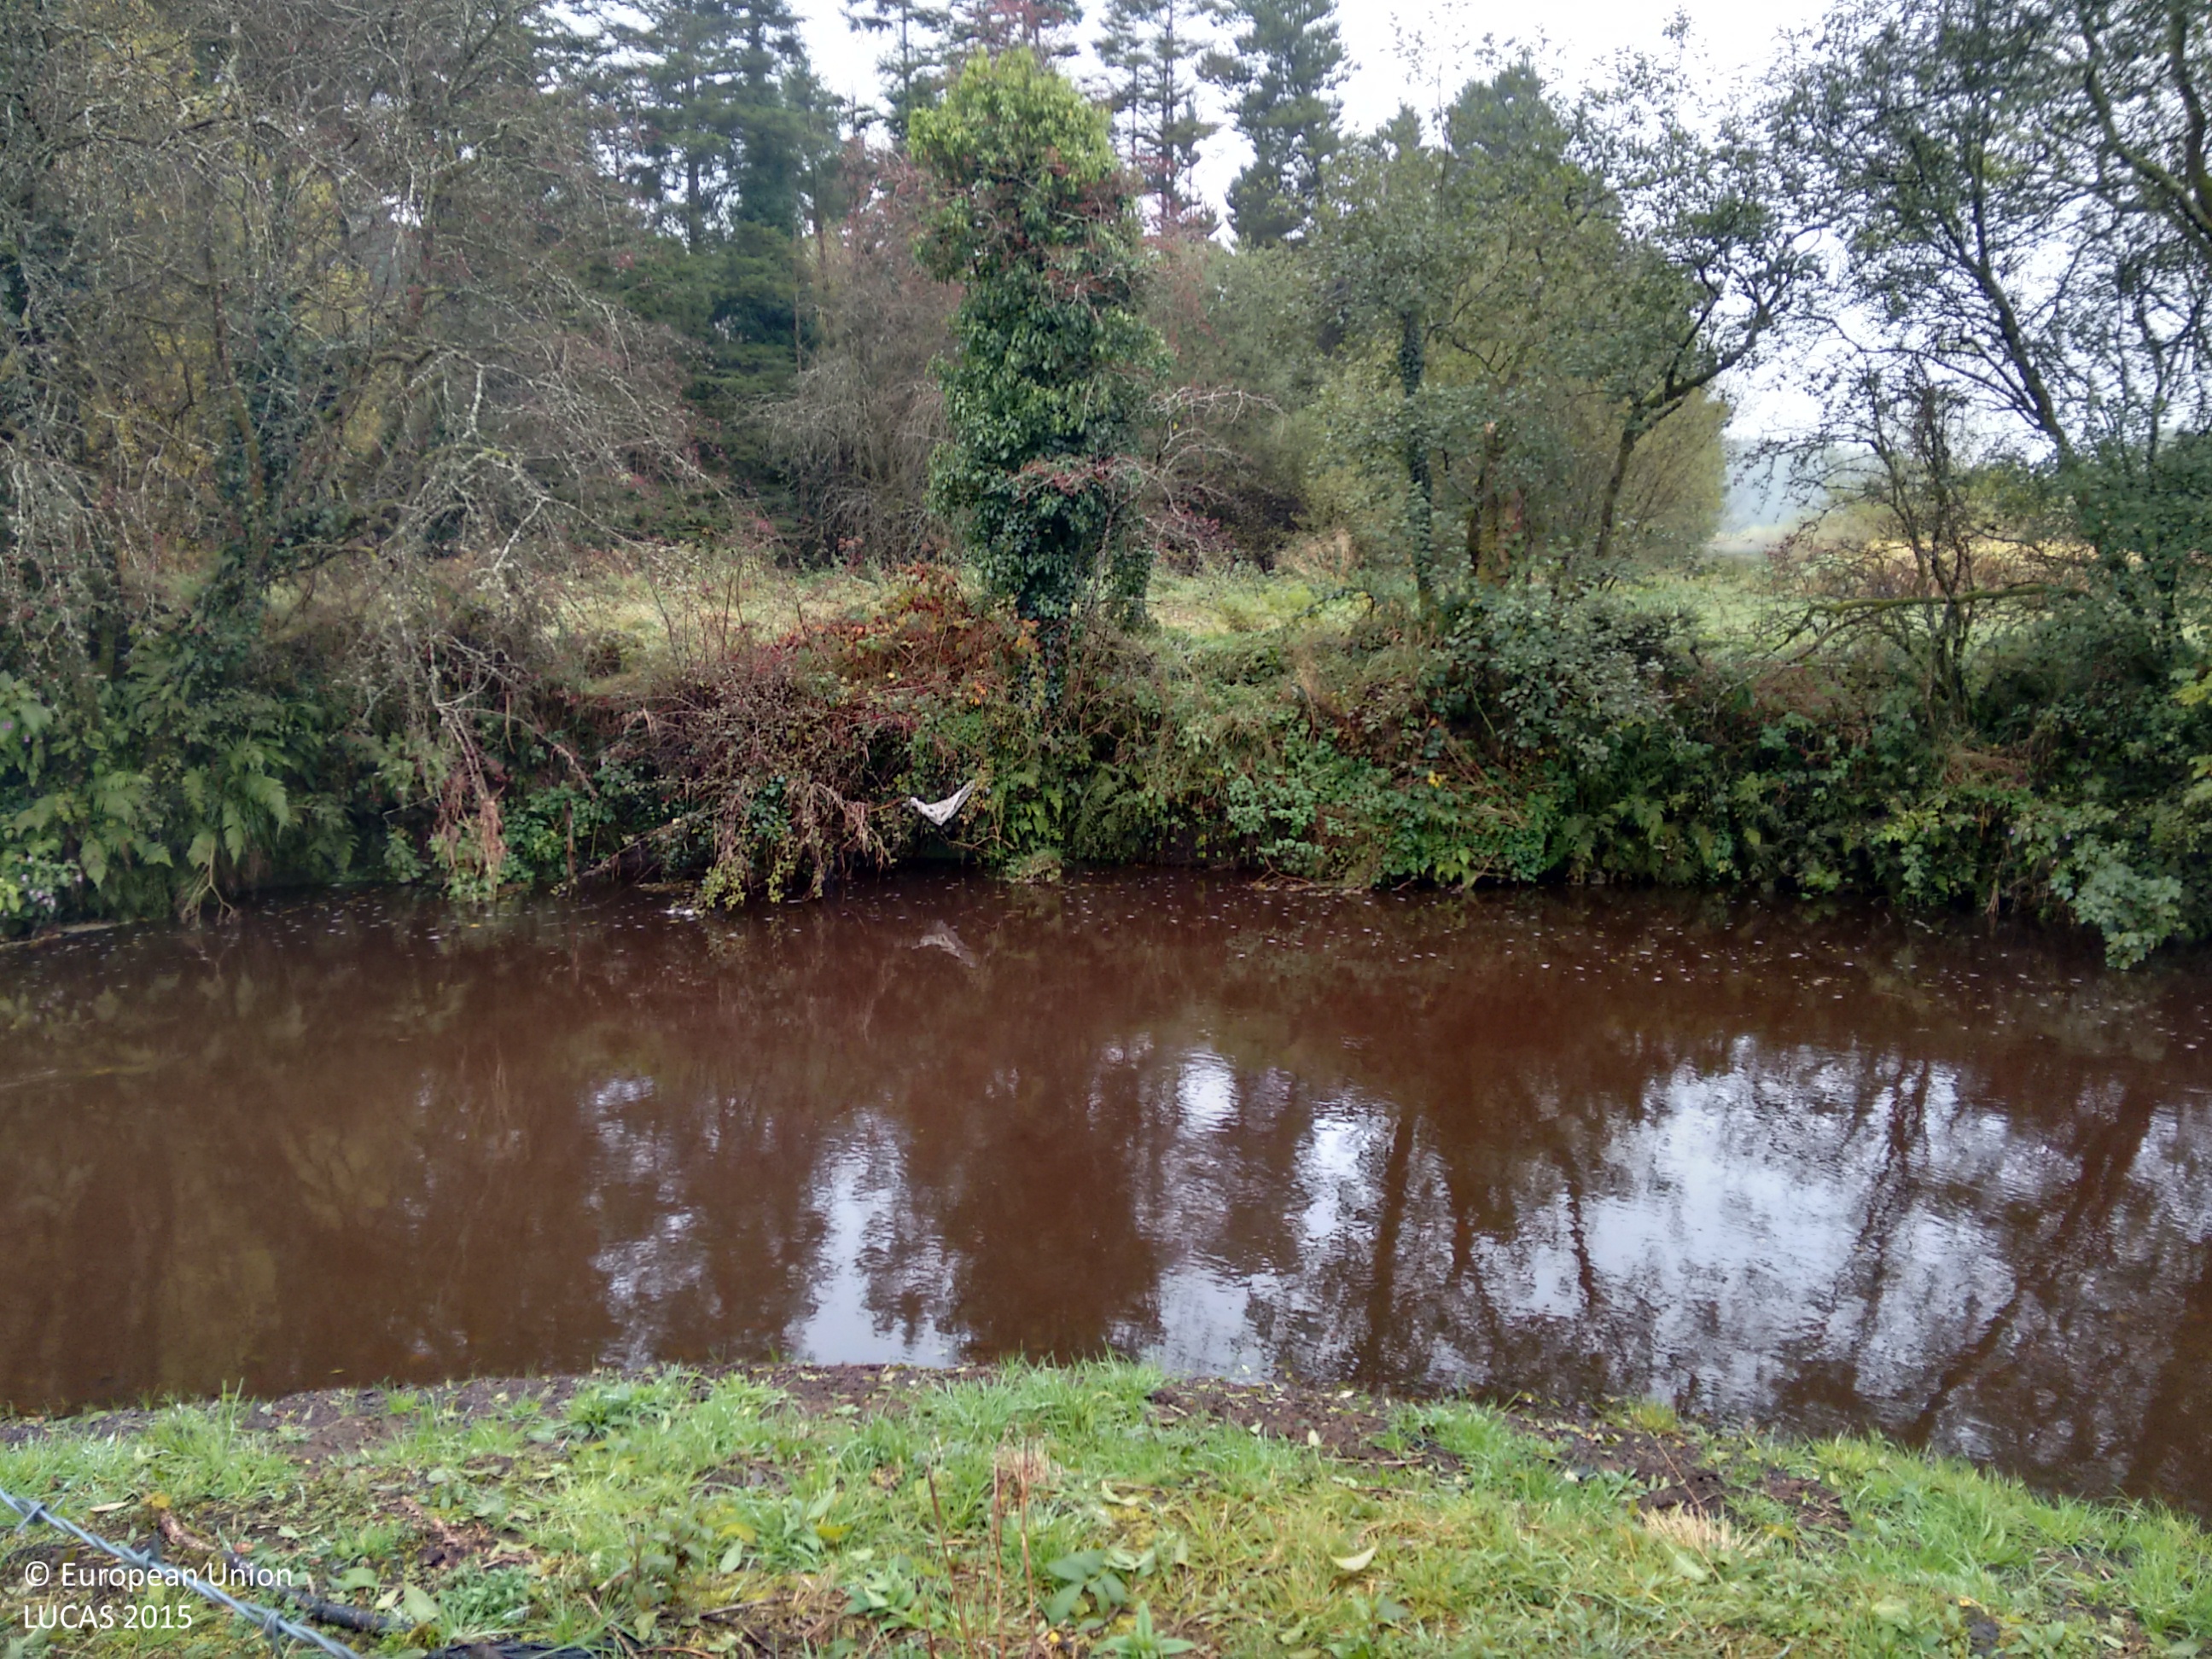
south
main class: Grassland
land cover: Grassland without tree/shrub cover
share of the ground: > 75 %
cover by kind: herbaceous plants 100 %
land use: Agriculture (excluding fallow land and kitchen gardens)
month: October
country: GB
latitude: 54.5351
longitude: -7.4477
